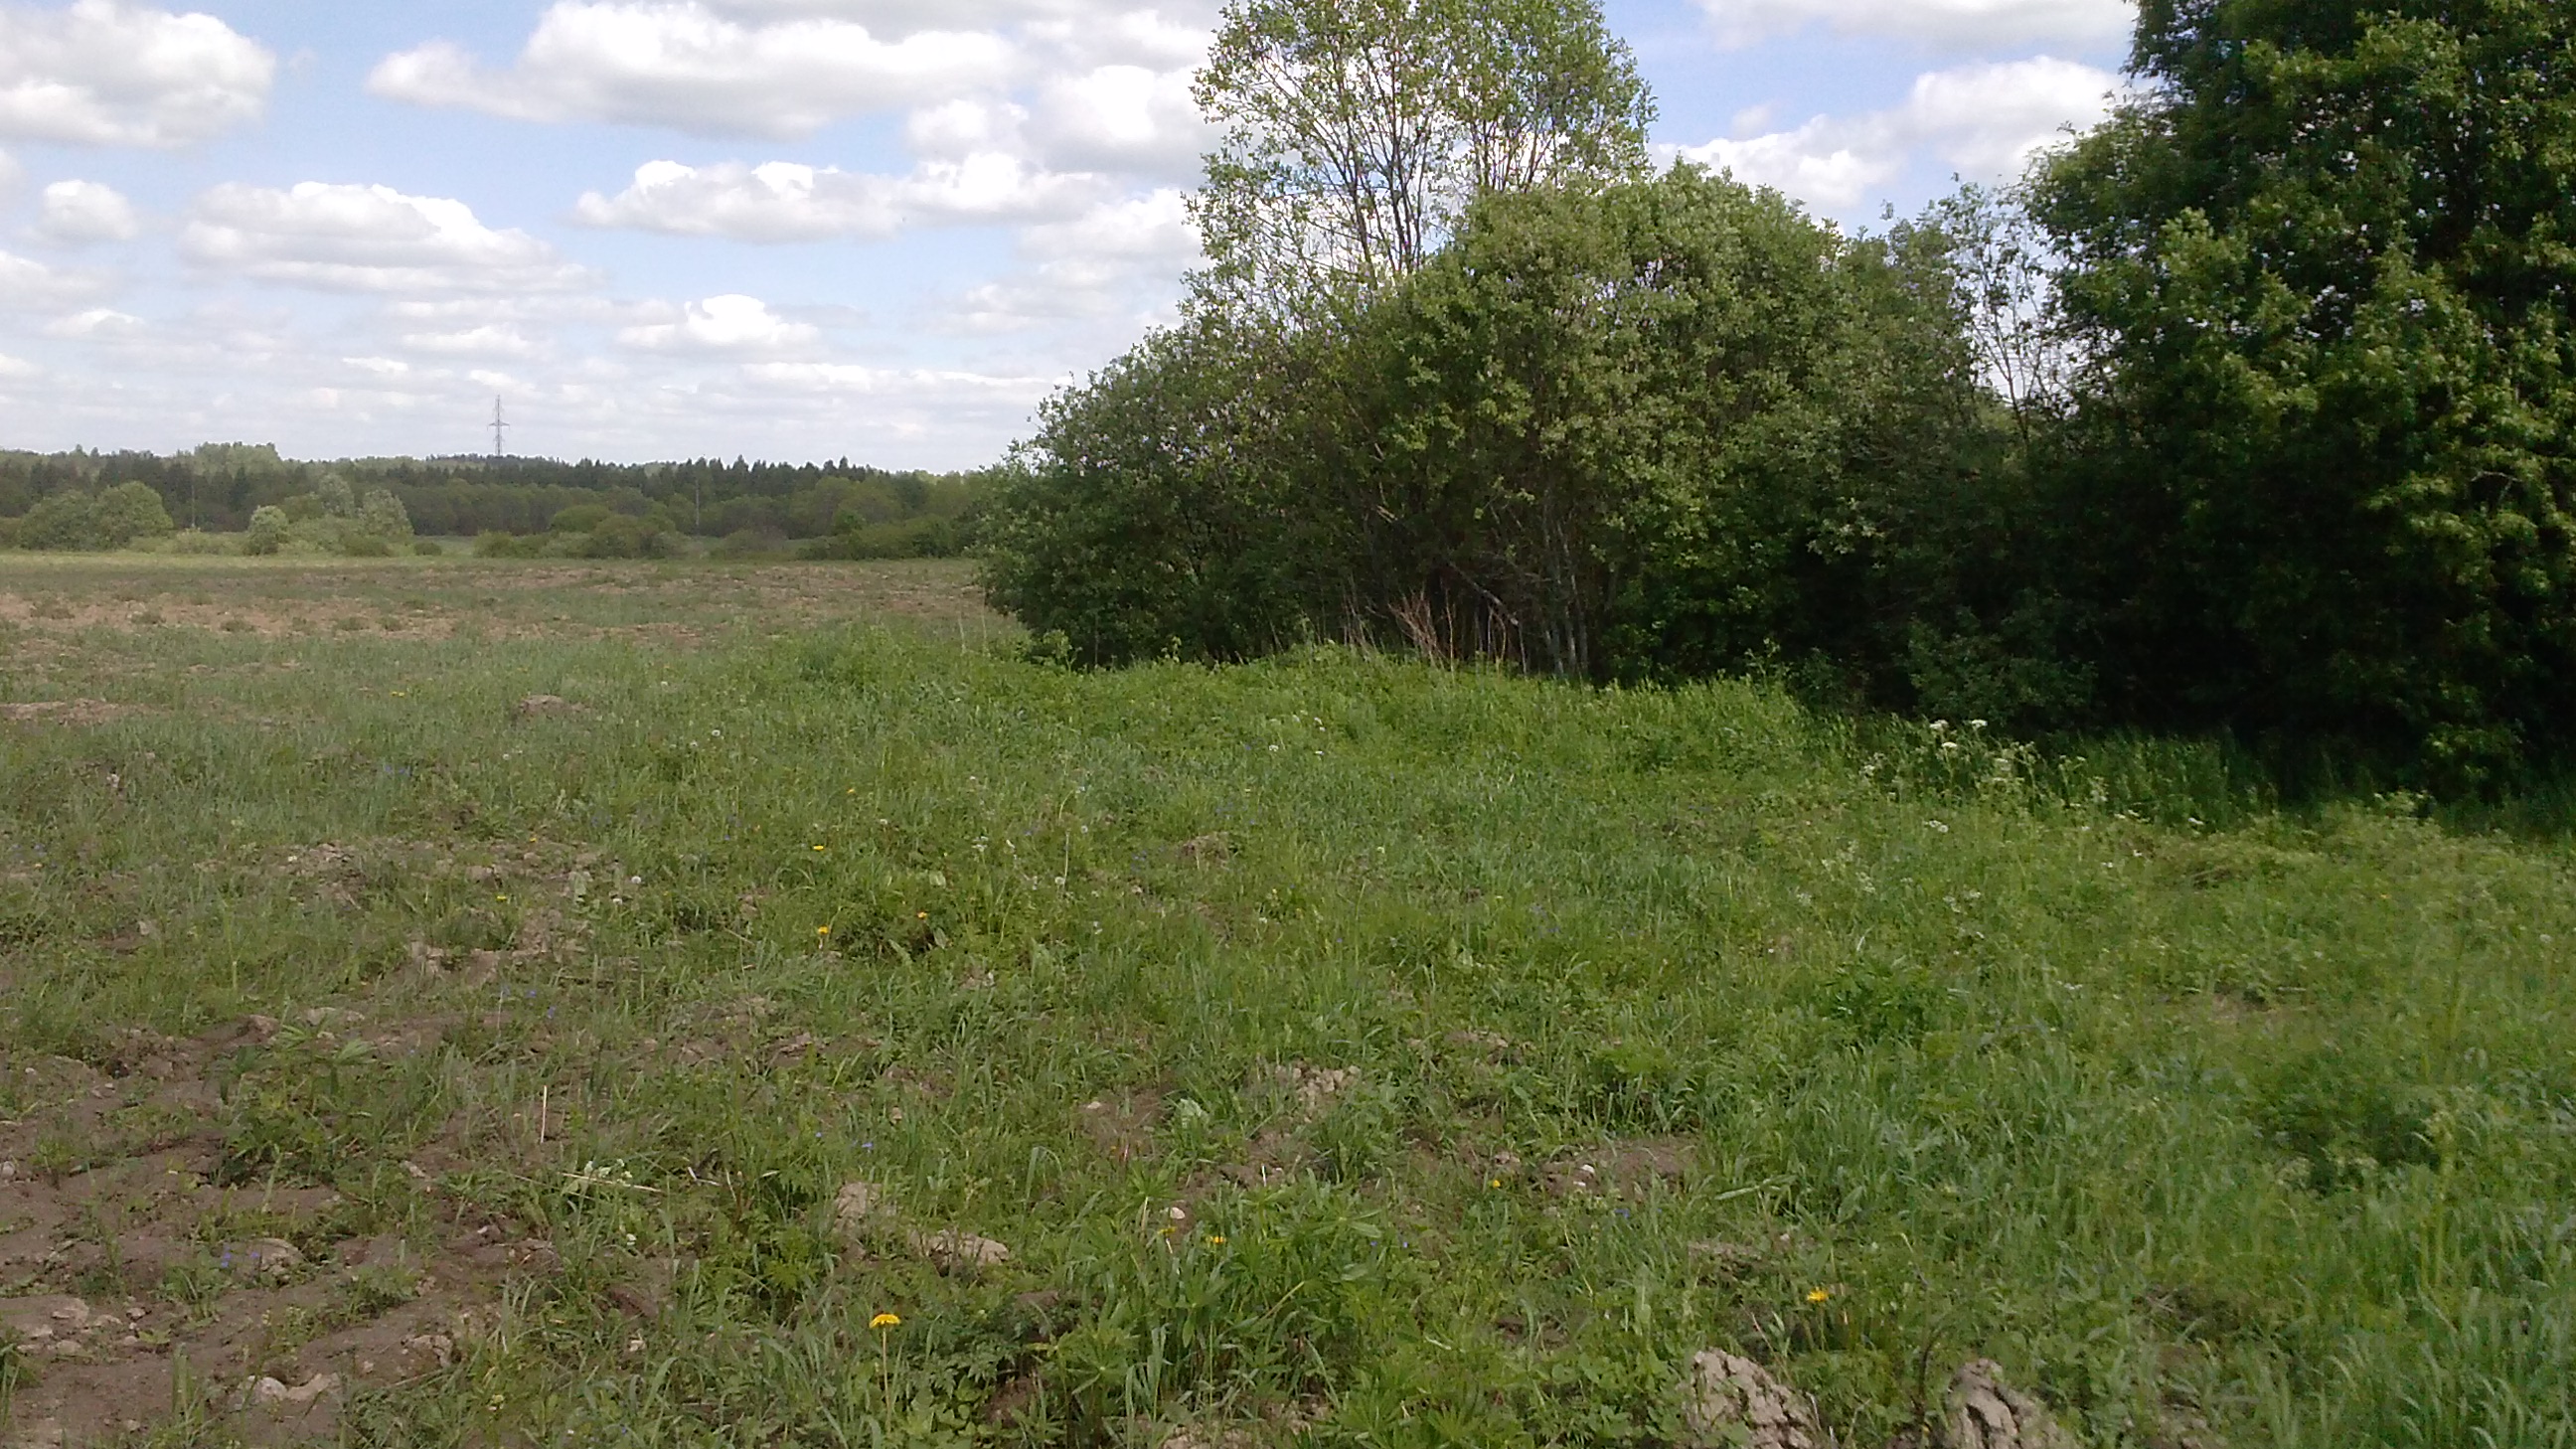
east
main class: Grassland
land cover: Grassland without tree/shrub cover
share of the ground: > 75 %
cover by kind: herbaceous plants 75 %, unconsolidated bare surface 25 %
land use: Agriculture (excluding fallow land and kitchen gardens)
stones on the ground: < 10 %
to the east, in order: Grassland without tree/shrub cover; Shrubland without tree cover; Broadleaved woodland; Grassland without tree/shrub cover; Abandoned hedges; Ditches and canals; Abandoned hedges; Tracks; Grassland without tree/shrub cover
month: May
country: LV
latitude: 56.3267
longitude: 27.1655
